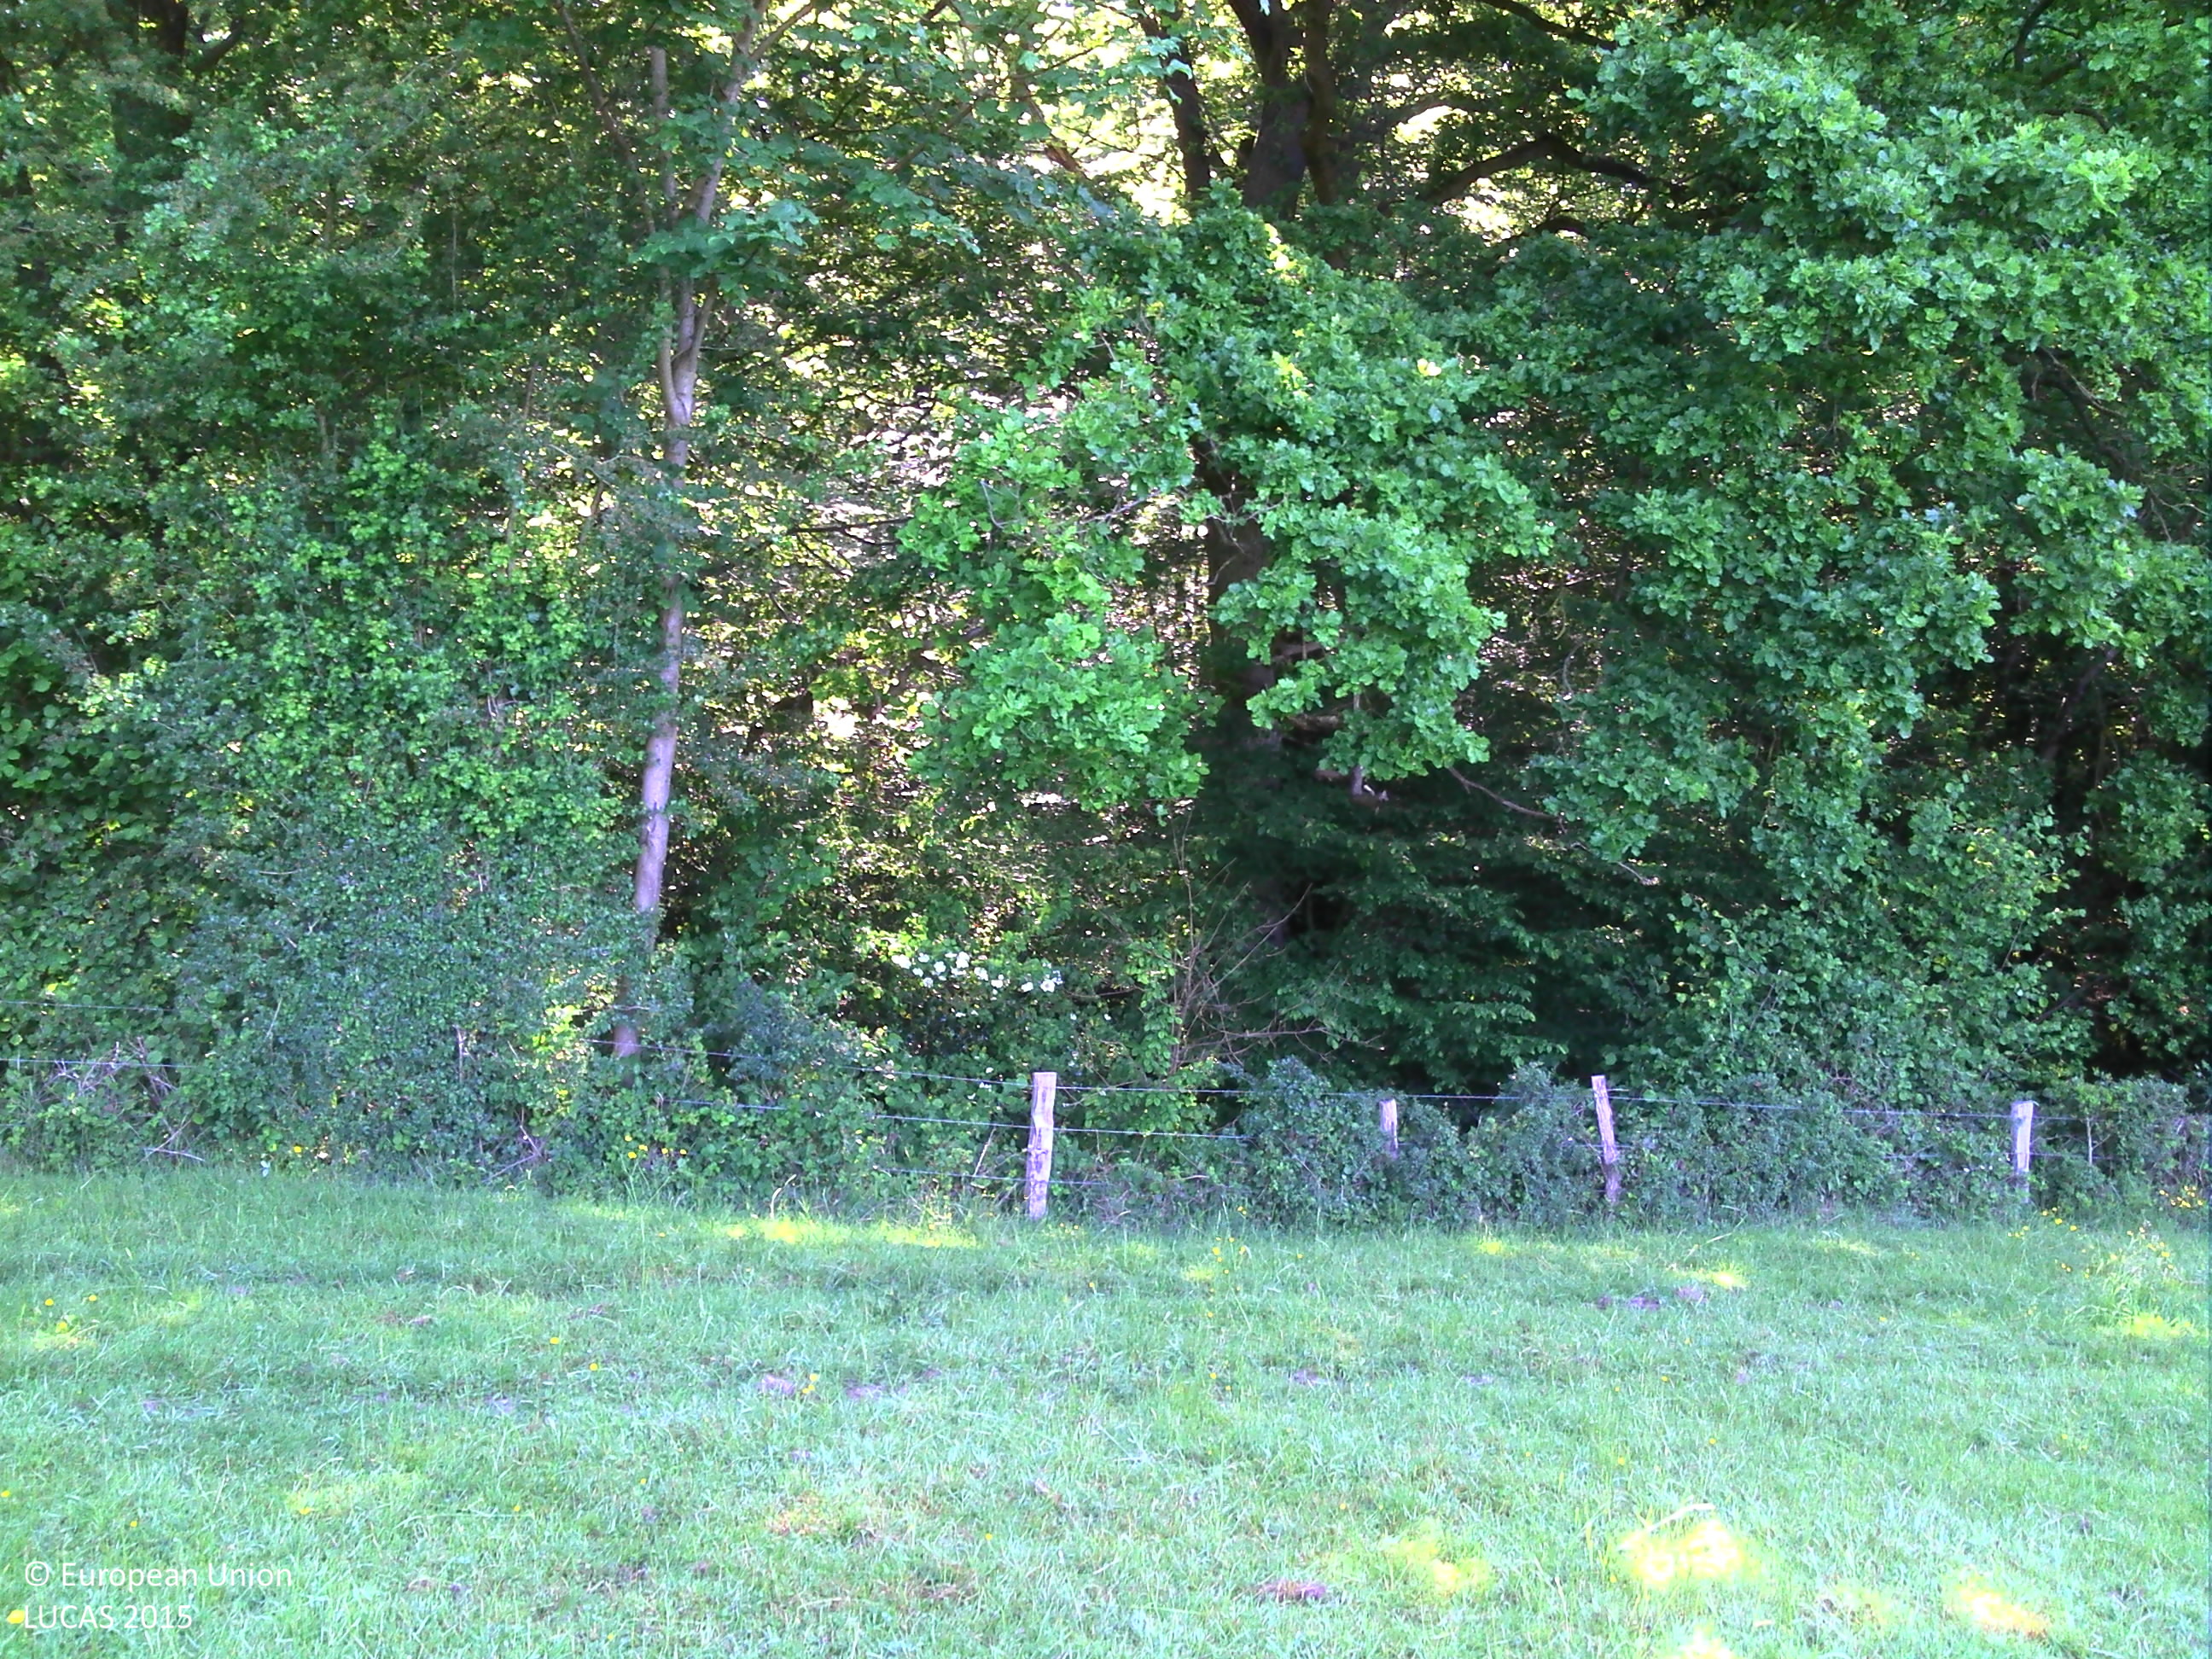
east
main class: Grassland
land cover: Grassland without tree/shrub cover
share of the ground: > 75 %
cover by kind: herbaceous plants 100 %
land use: Agriculture (excluding fallow land and kitchen gardens)
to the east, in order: Grassland without tree/shrub cover; Fences; Broadleaved woodland; Rivers and streams; Broadleaved woodland; Tracks; Broadleaved woodland; Rivers and streams; Broadleaved woodland; Paved roads, cycling and walking lanes; Broadleaved woodland
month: June
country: BE
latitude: 50.5499
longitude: 5.6092
